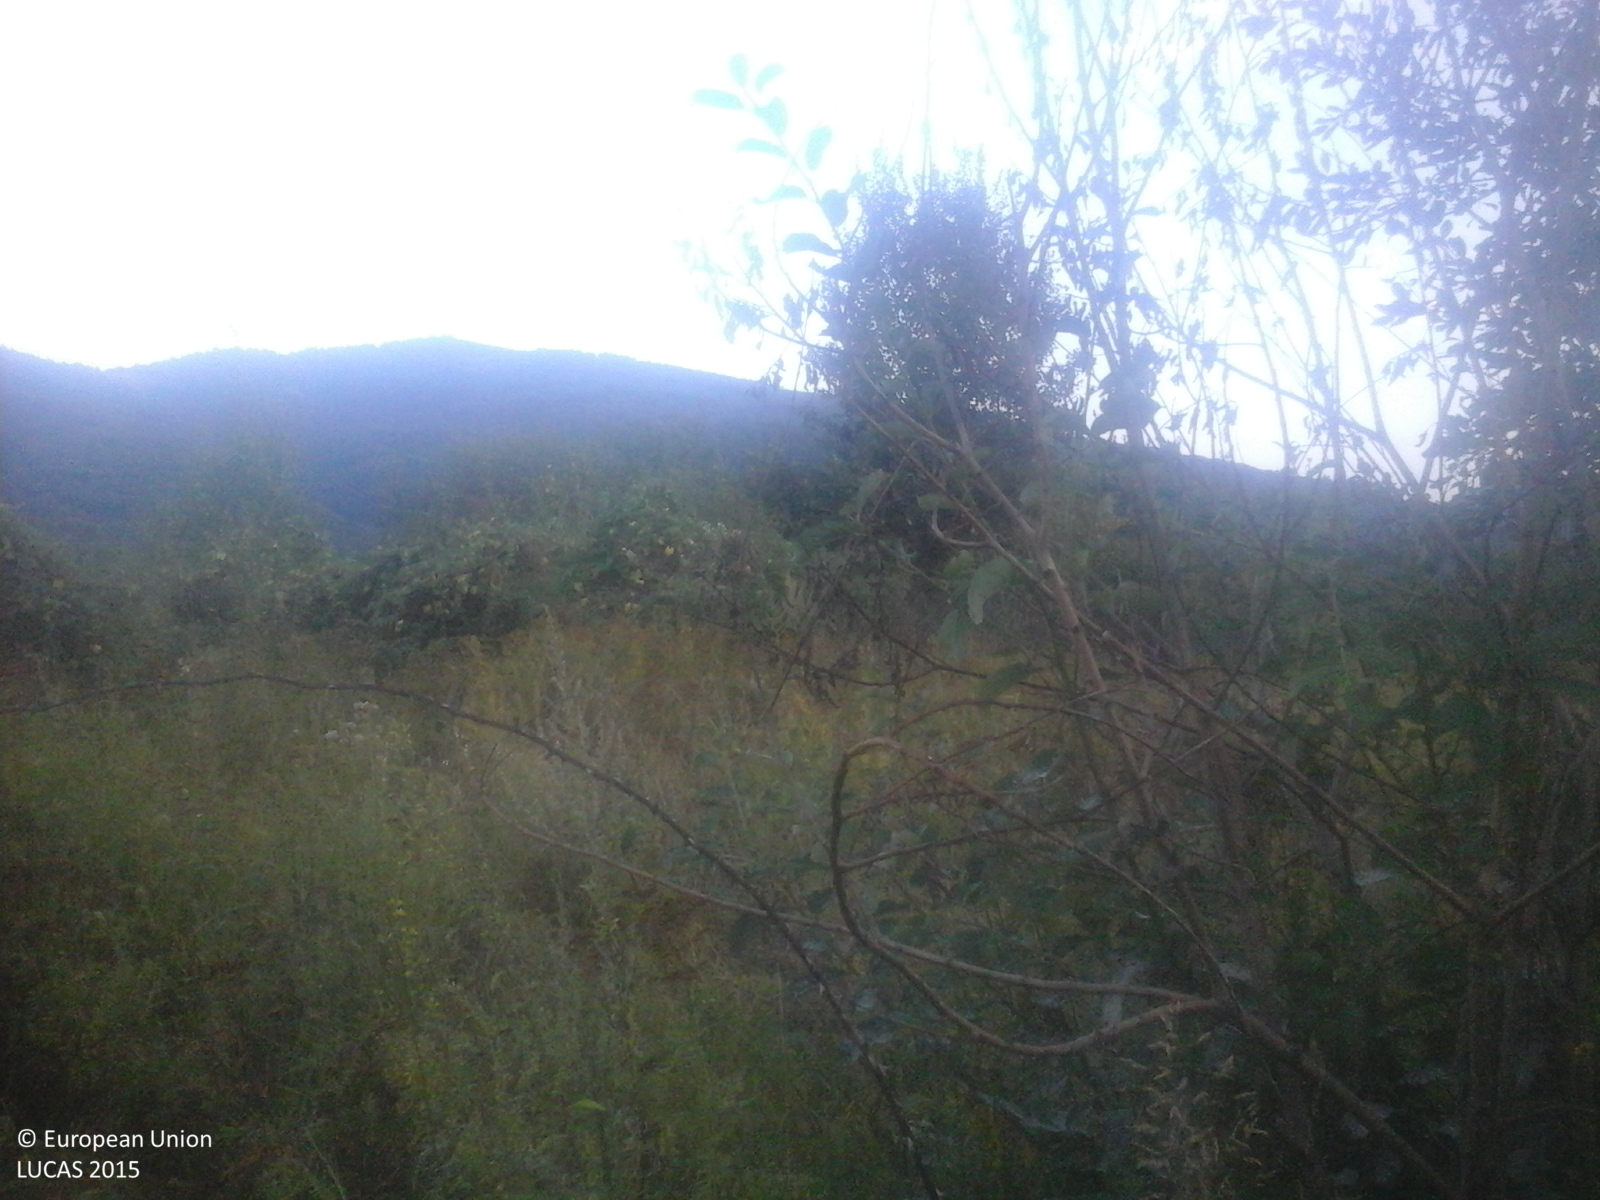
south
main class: Grassland
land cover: Grassland with sparse tree/shrub cover
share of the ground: > 75 %
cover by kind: herbaceous plants 85 %, shrubs 10 %, broadleaved forest trees 5 %
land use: Agriculture (excluding fallow land and kitchen gardens)
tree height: < 5 m
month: September
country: RO
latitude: 47.6547
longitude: 24.2693
